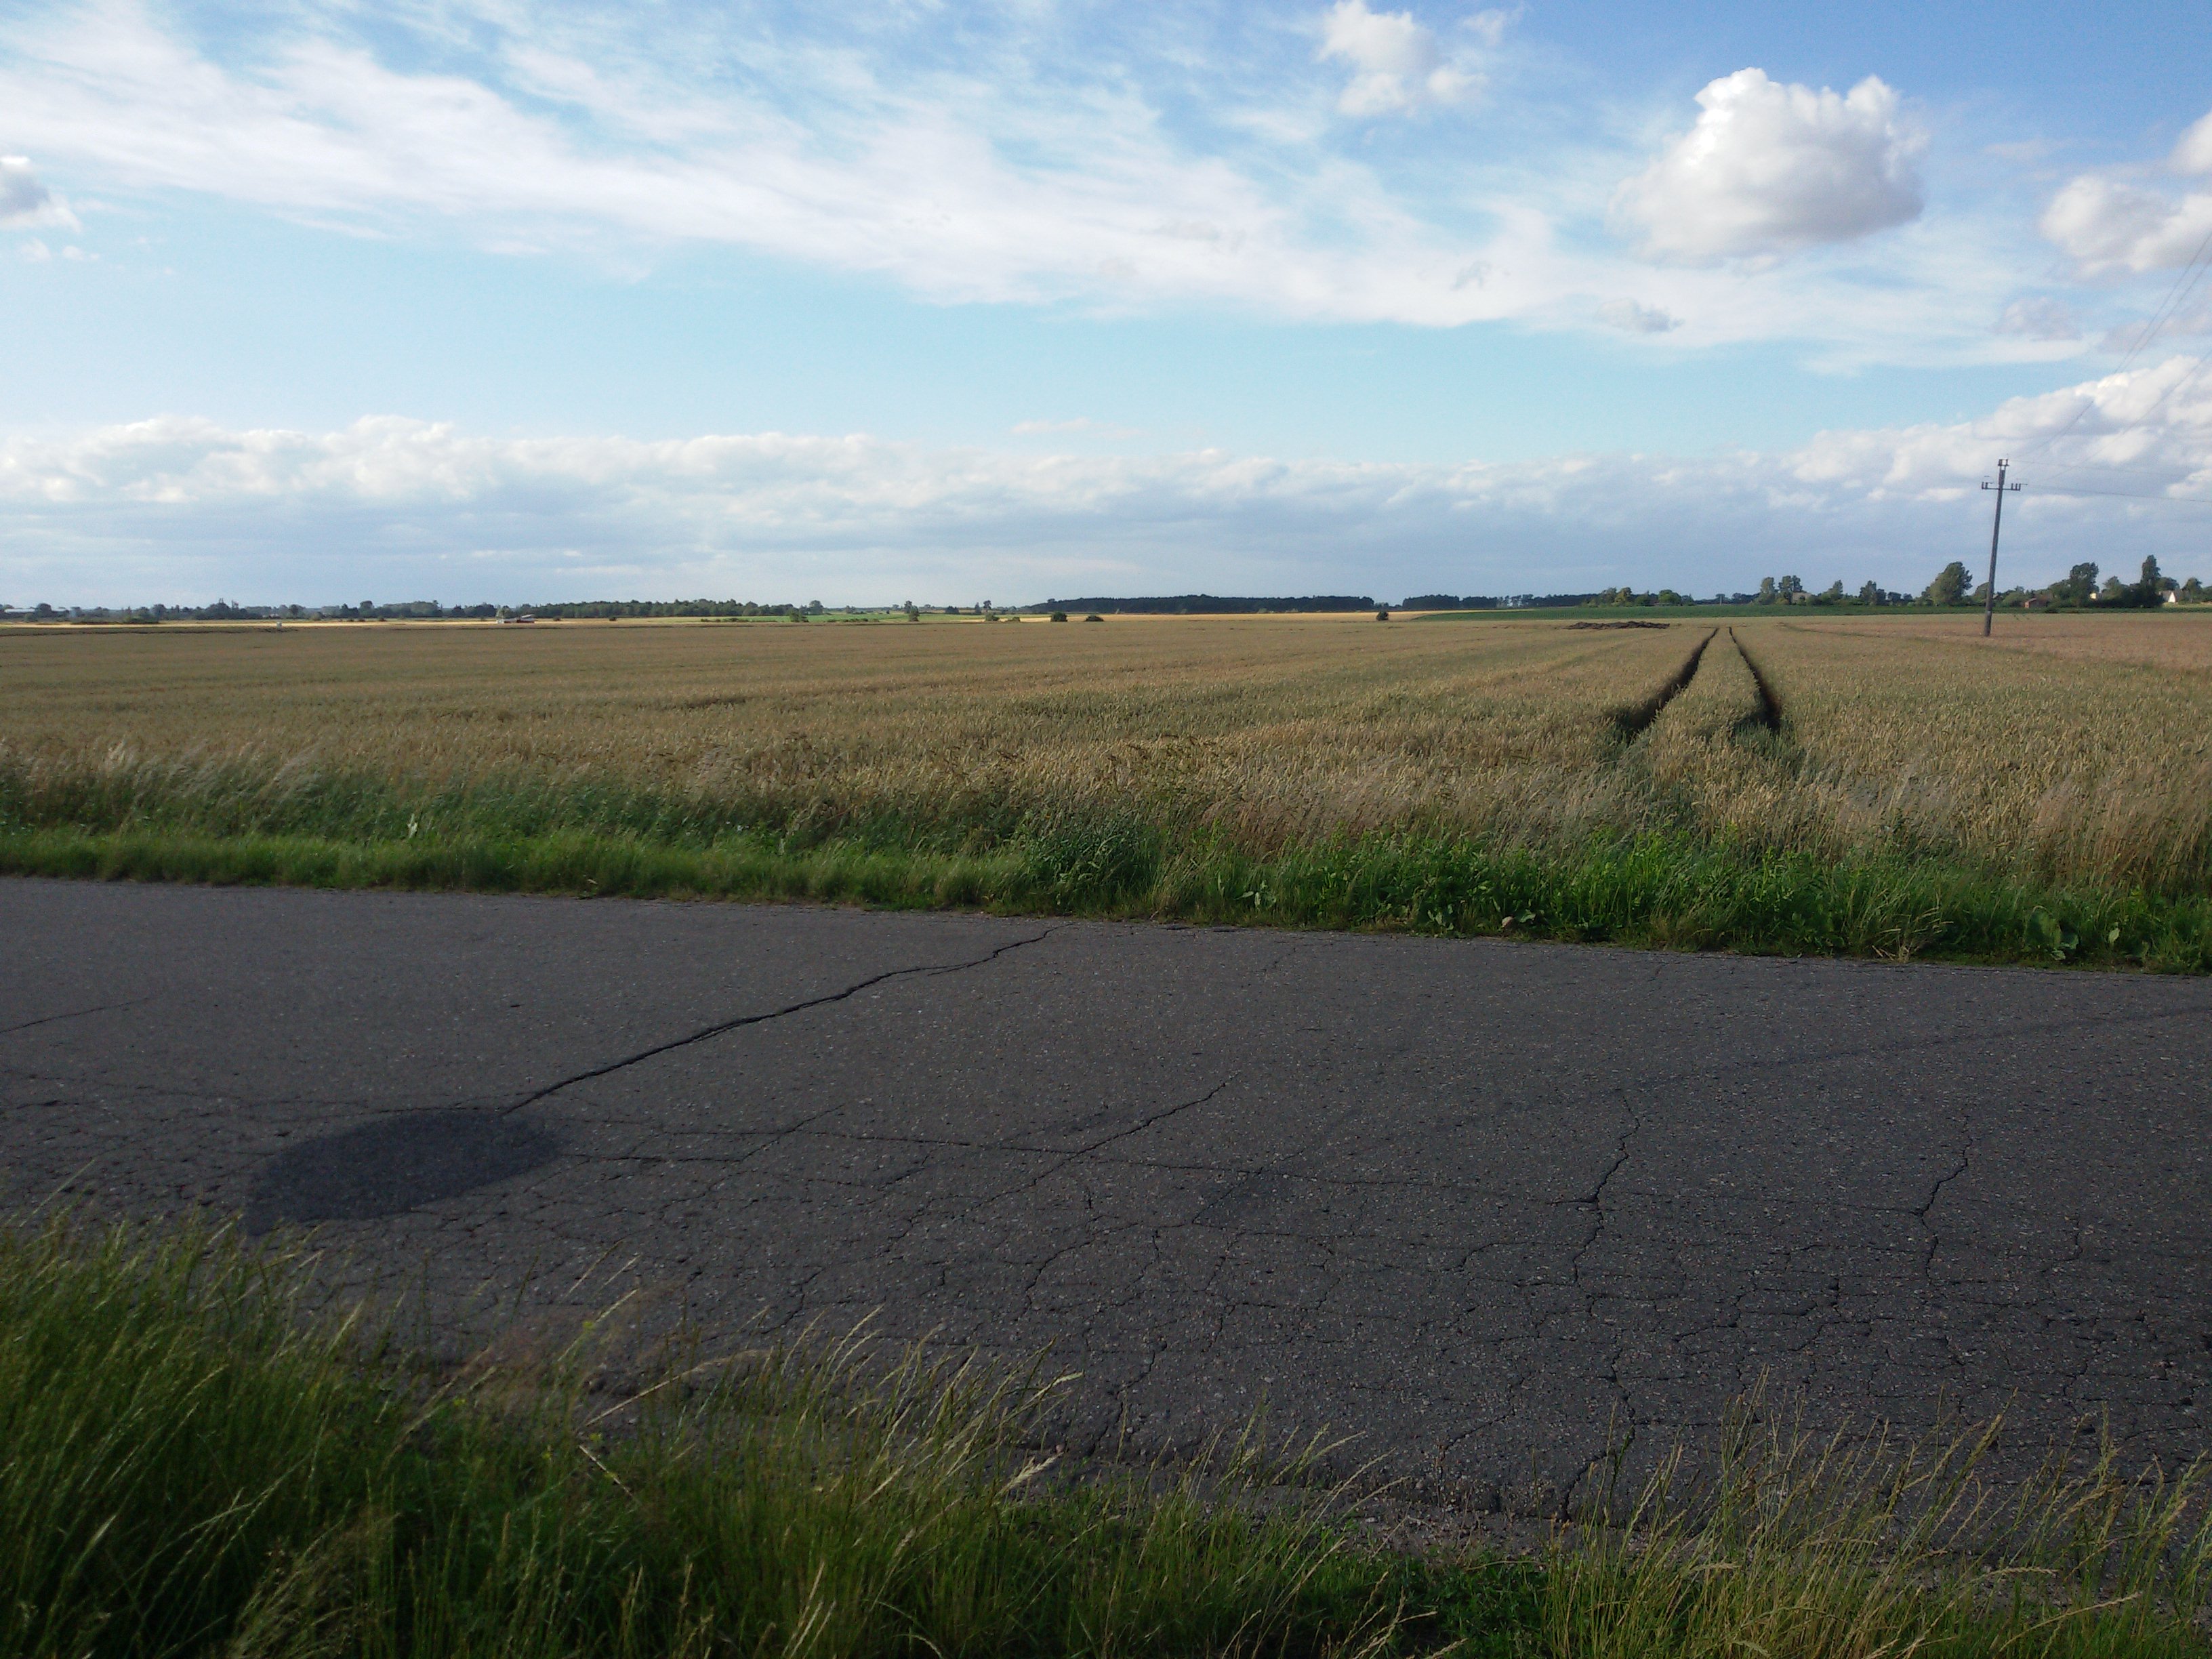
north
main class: Cropland
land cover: Rape and turnip rape
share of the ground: > 75 %
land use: Agriculture (excluding fallow land and kitchen gardens)
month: July
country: PL
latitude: 52.6613
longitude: 17.5382
